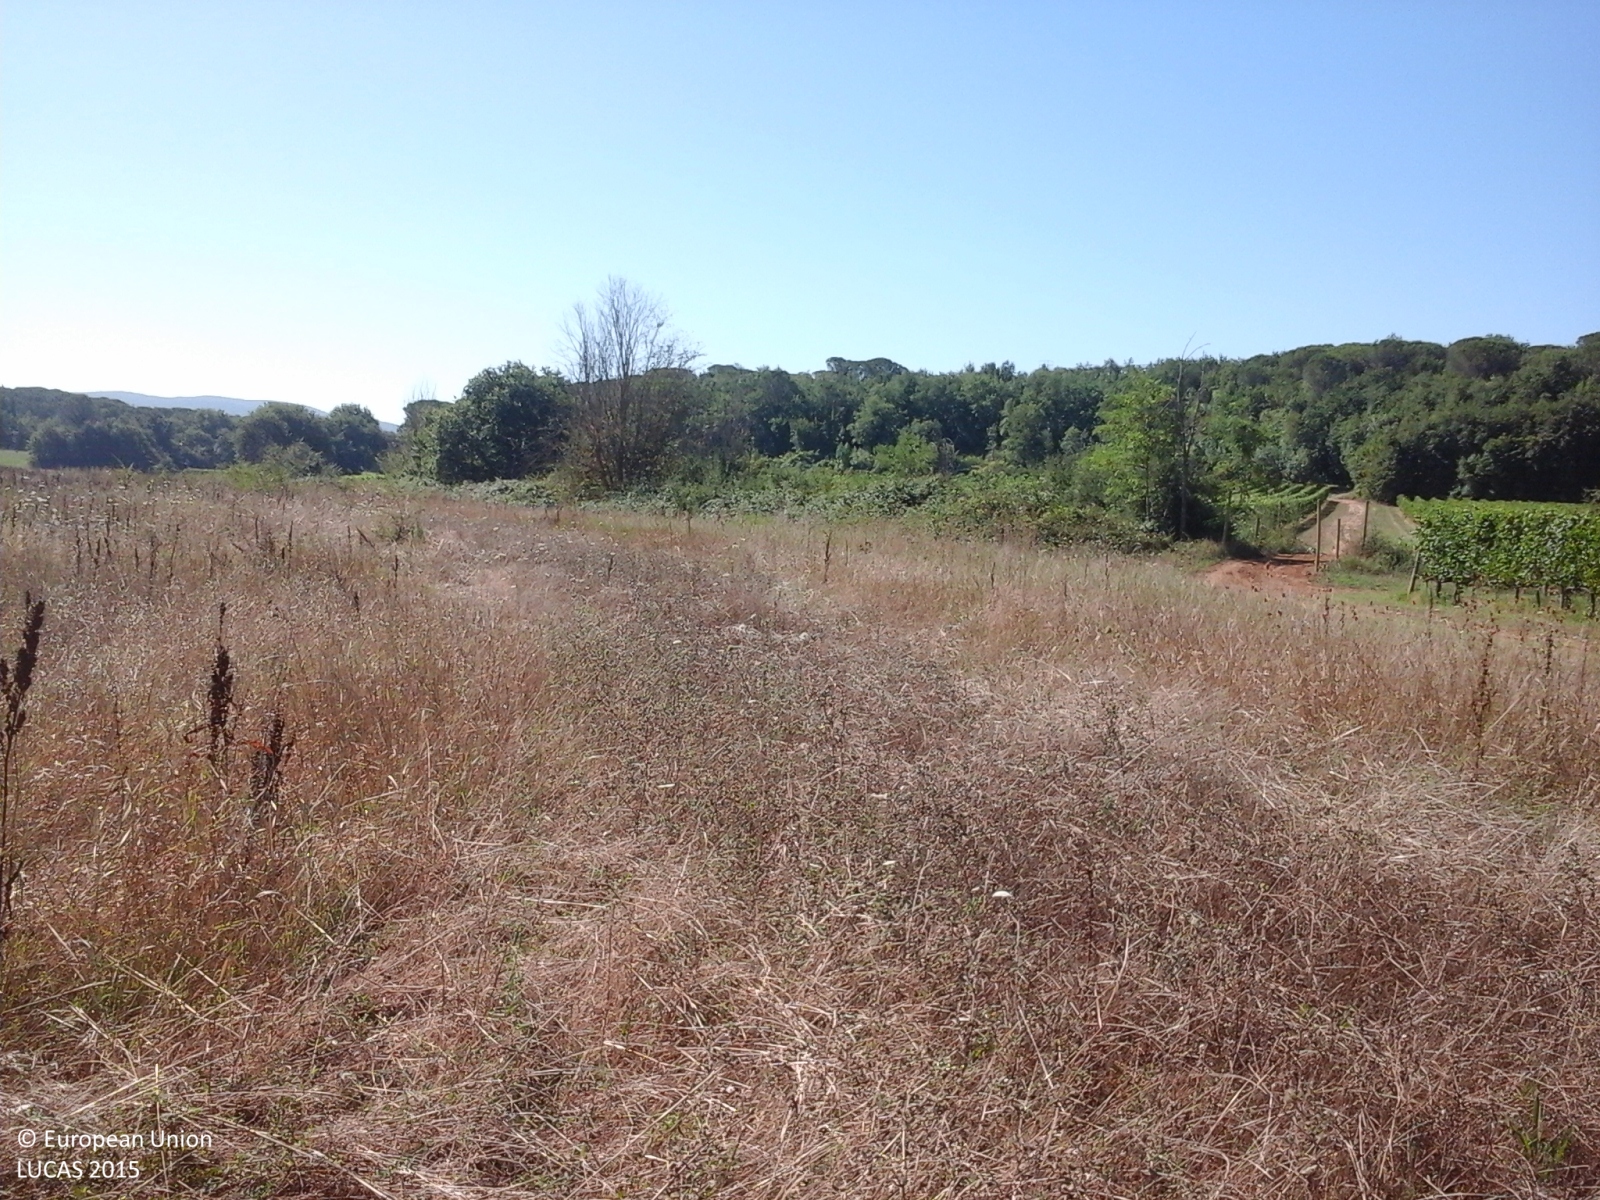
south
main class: Grassland
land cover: Grassland without tree/shrub cover
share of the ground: > 75 %
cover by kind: herbaceous plants 100 %
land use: Agriculture (excluding fallow land and kitchen gardens)
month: August
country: IT
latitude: 43.3879
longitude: 11.1448
